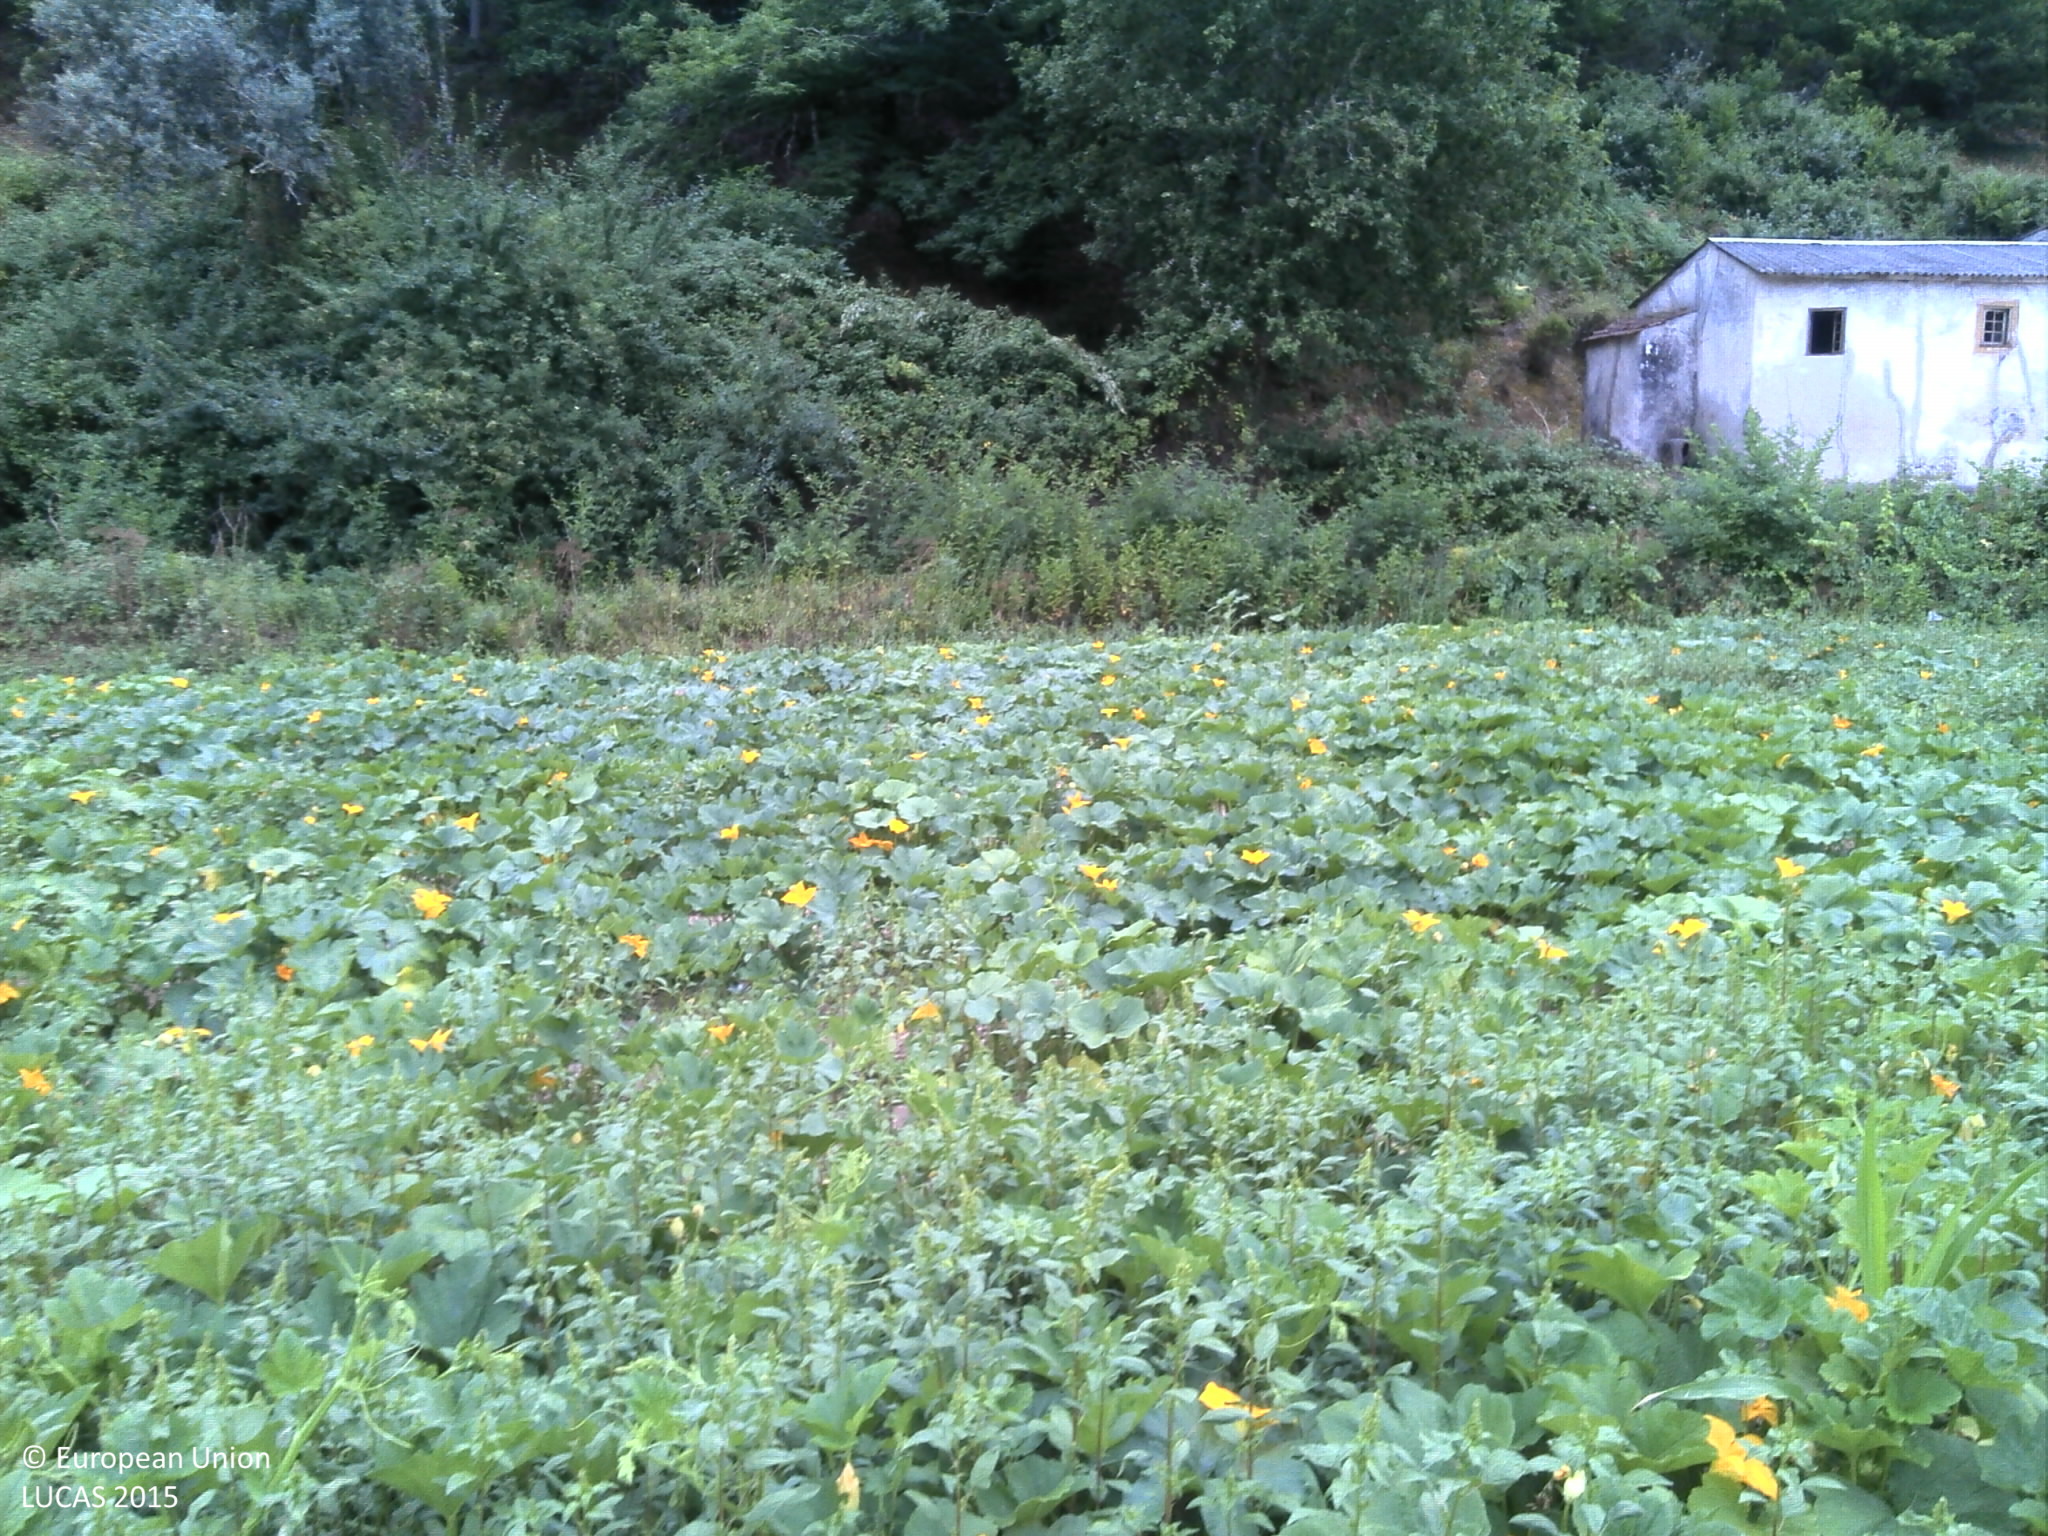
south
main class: Grassland
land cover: Grassland without tree/shrub cover
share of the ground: > 75 %
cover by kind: herbaceous plants 75 %, consolidated bare surface 15 %, unconsolidated bare surface 10 %
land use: Agriculture (excluding fallow land and kitchen gardens)
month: July
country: PT
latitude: 40.3820
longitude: -8.2813
